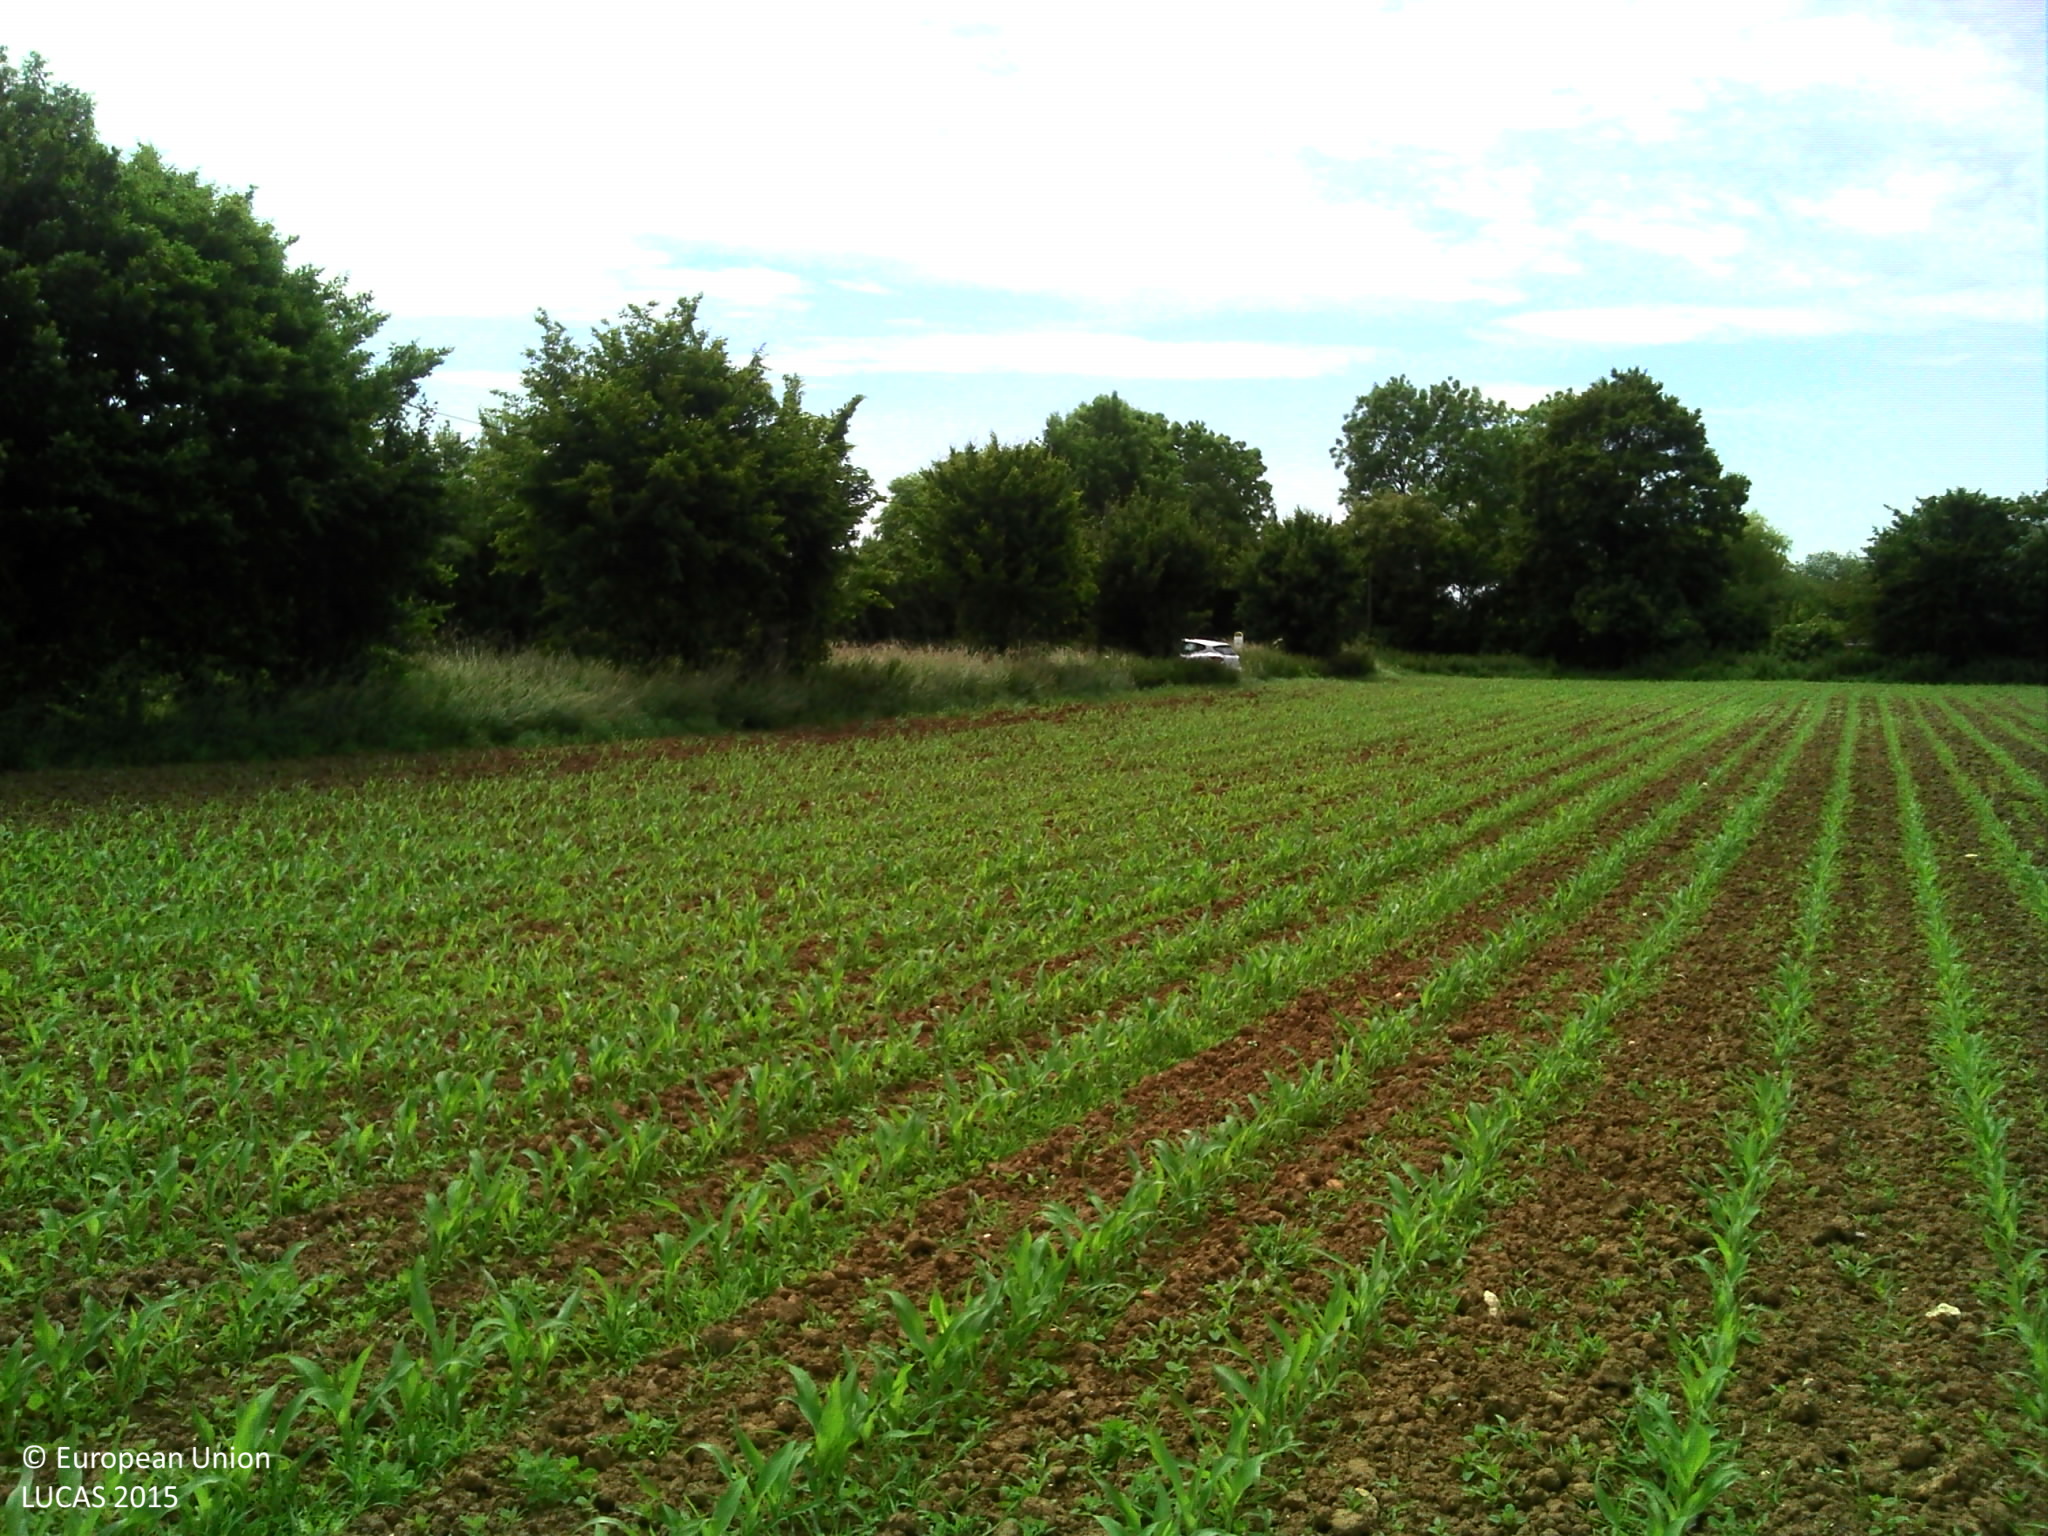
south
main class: Cropland
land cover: Maize
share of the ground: 10 - 25 %
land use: Agriculture (excluding fallow land and kitchen gardens)
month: June
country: FR
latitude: 49.1635
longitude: -0.0010
